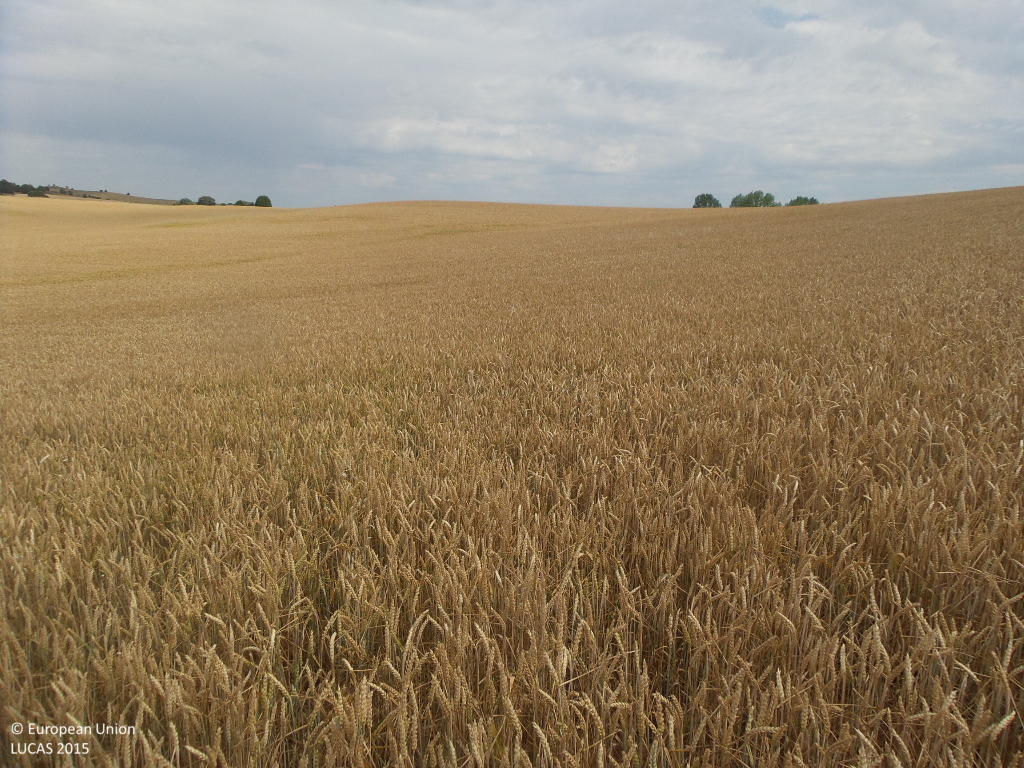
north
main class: Cropland
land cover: Common wheat
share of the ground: > 75 %
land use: Agriculture (excluding fallow land and kitchen gardens)
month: June
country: ES
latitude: 41.5321
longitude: -3.0466
